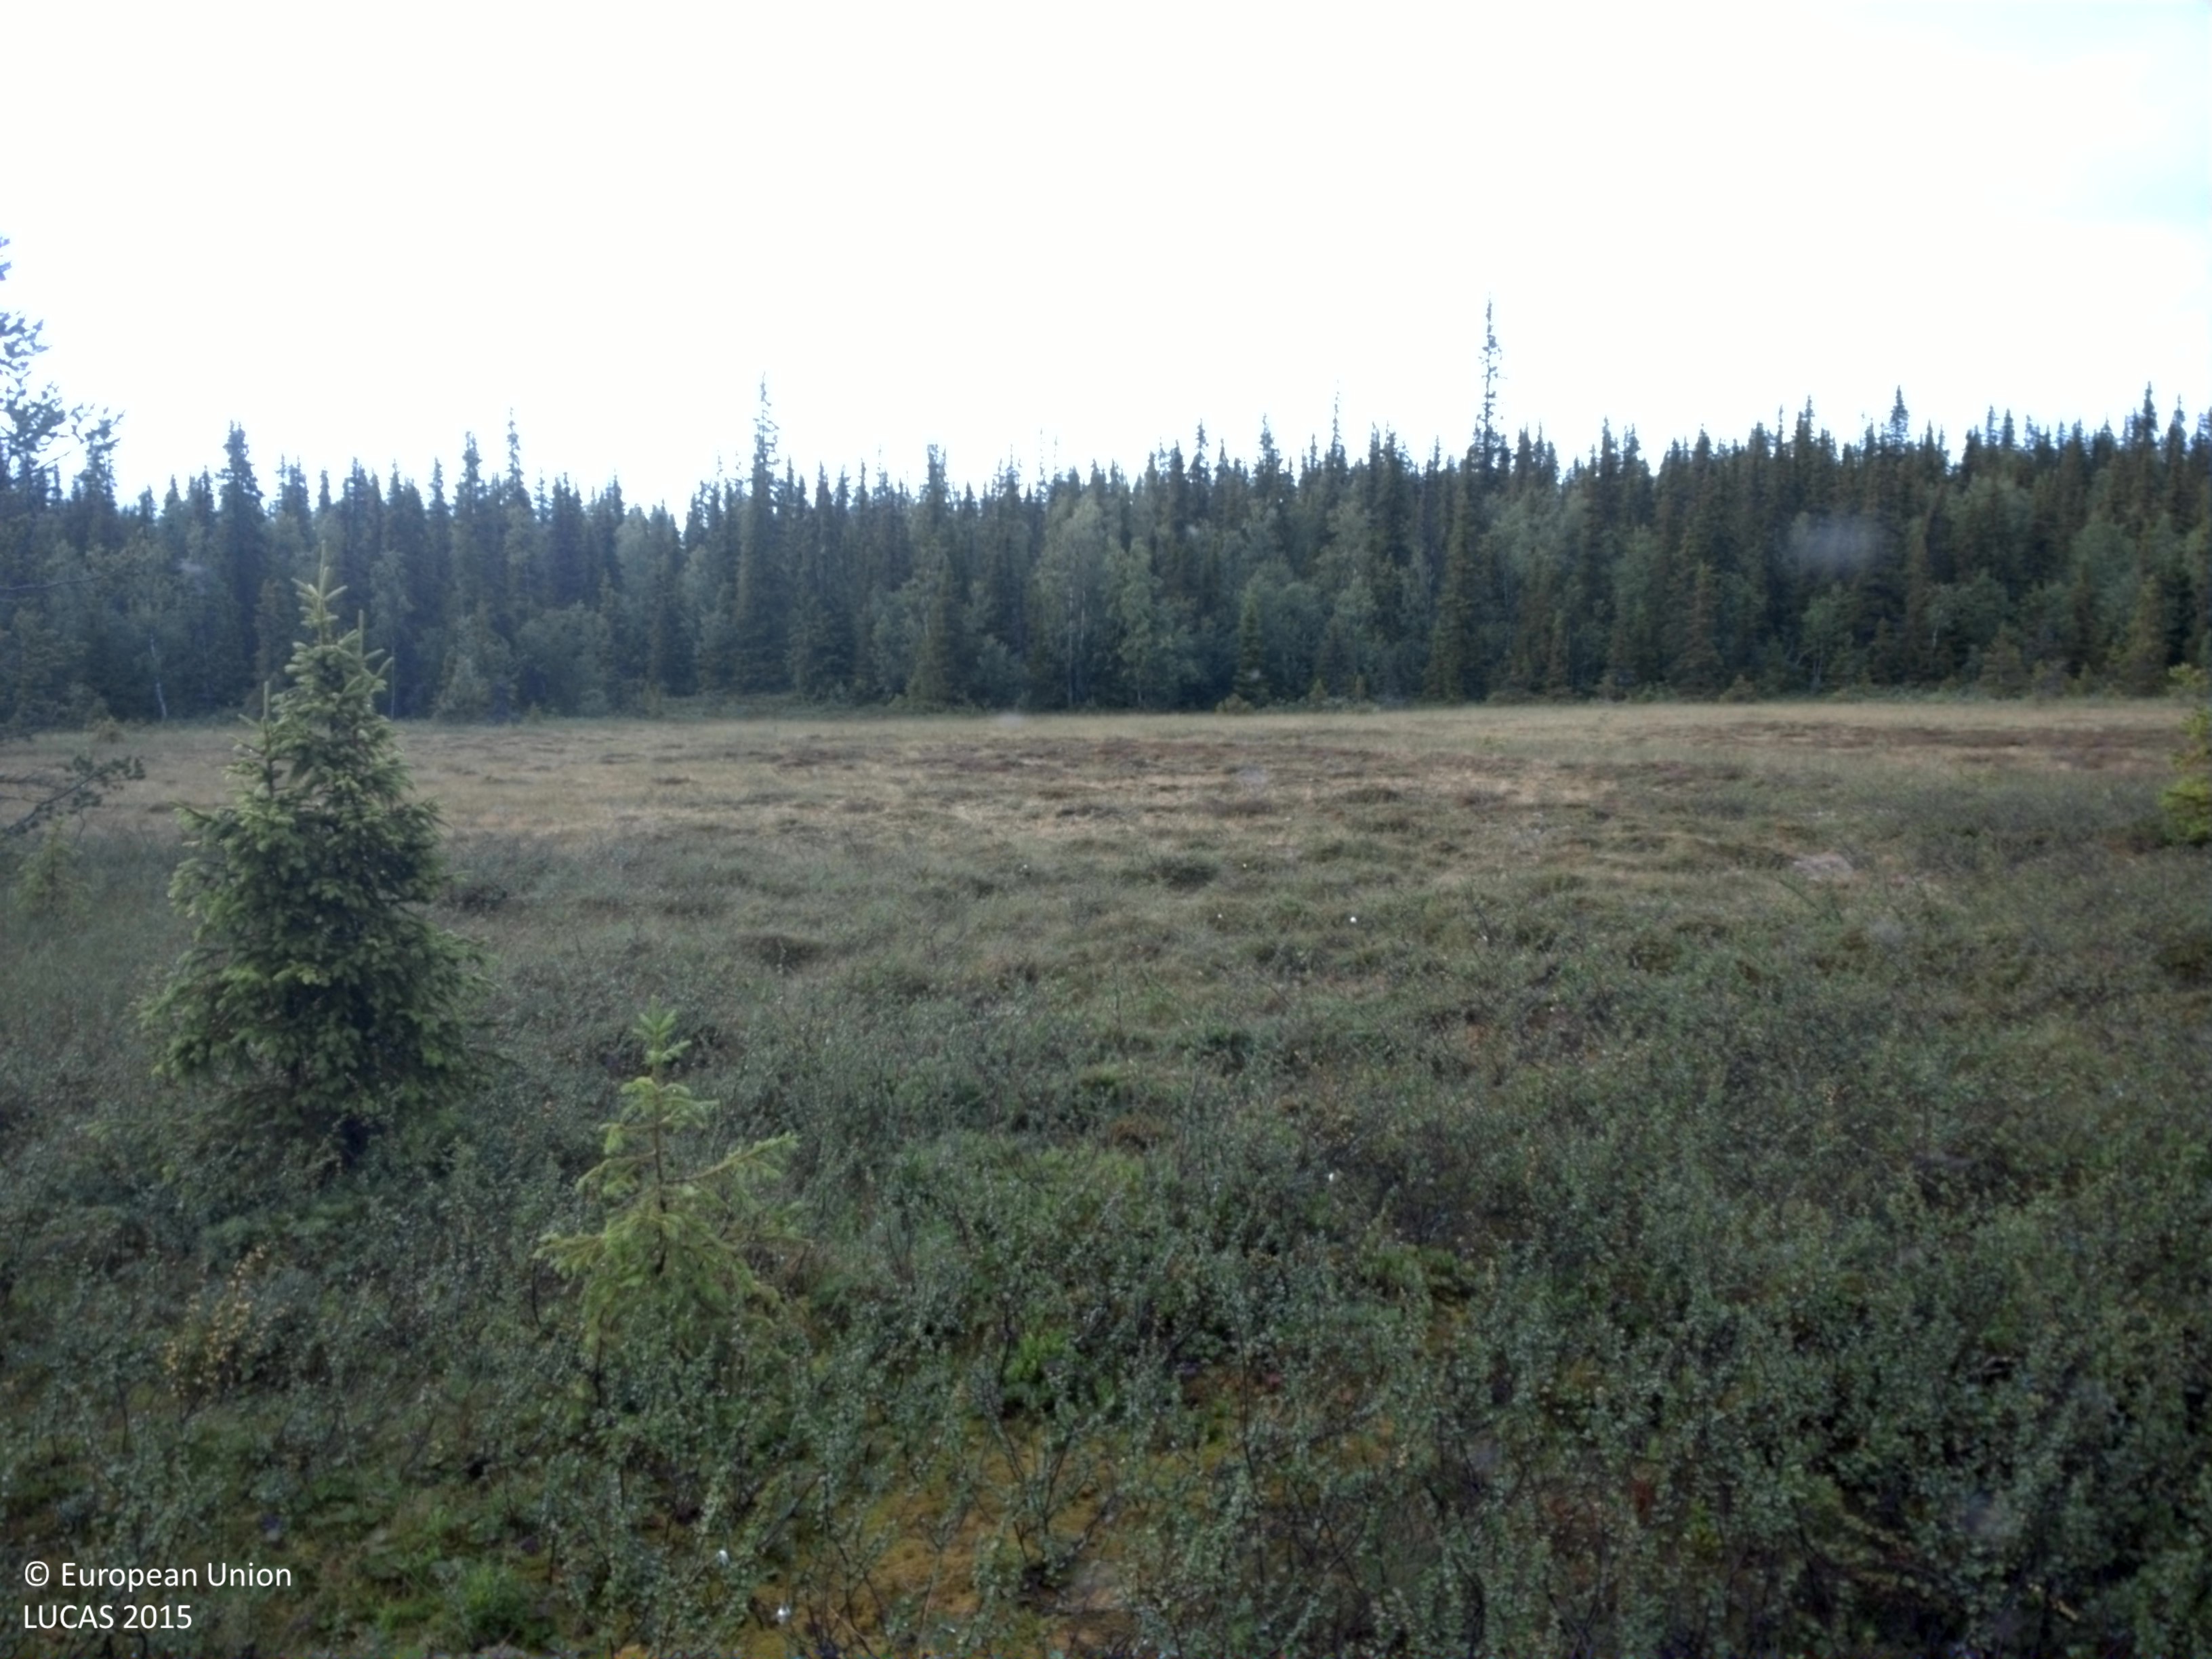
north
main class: Shrubland
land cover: Shrubland with sparse tree cover
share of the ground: 50 - 75 %
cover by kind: shrubs 50 %, lichens and mosses 35 %, herbaceous plants 10 %, coniferous forest trees 5 %
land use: Semi-natural and natural areas not in use
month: August
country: SE
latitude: 65.2550
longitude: 15.7248
